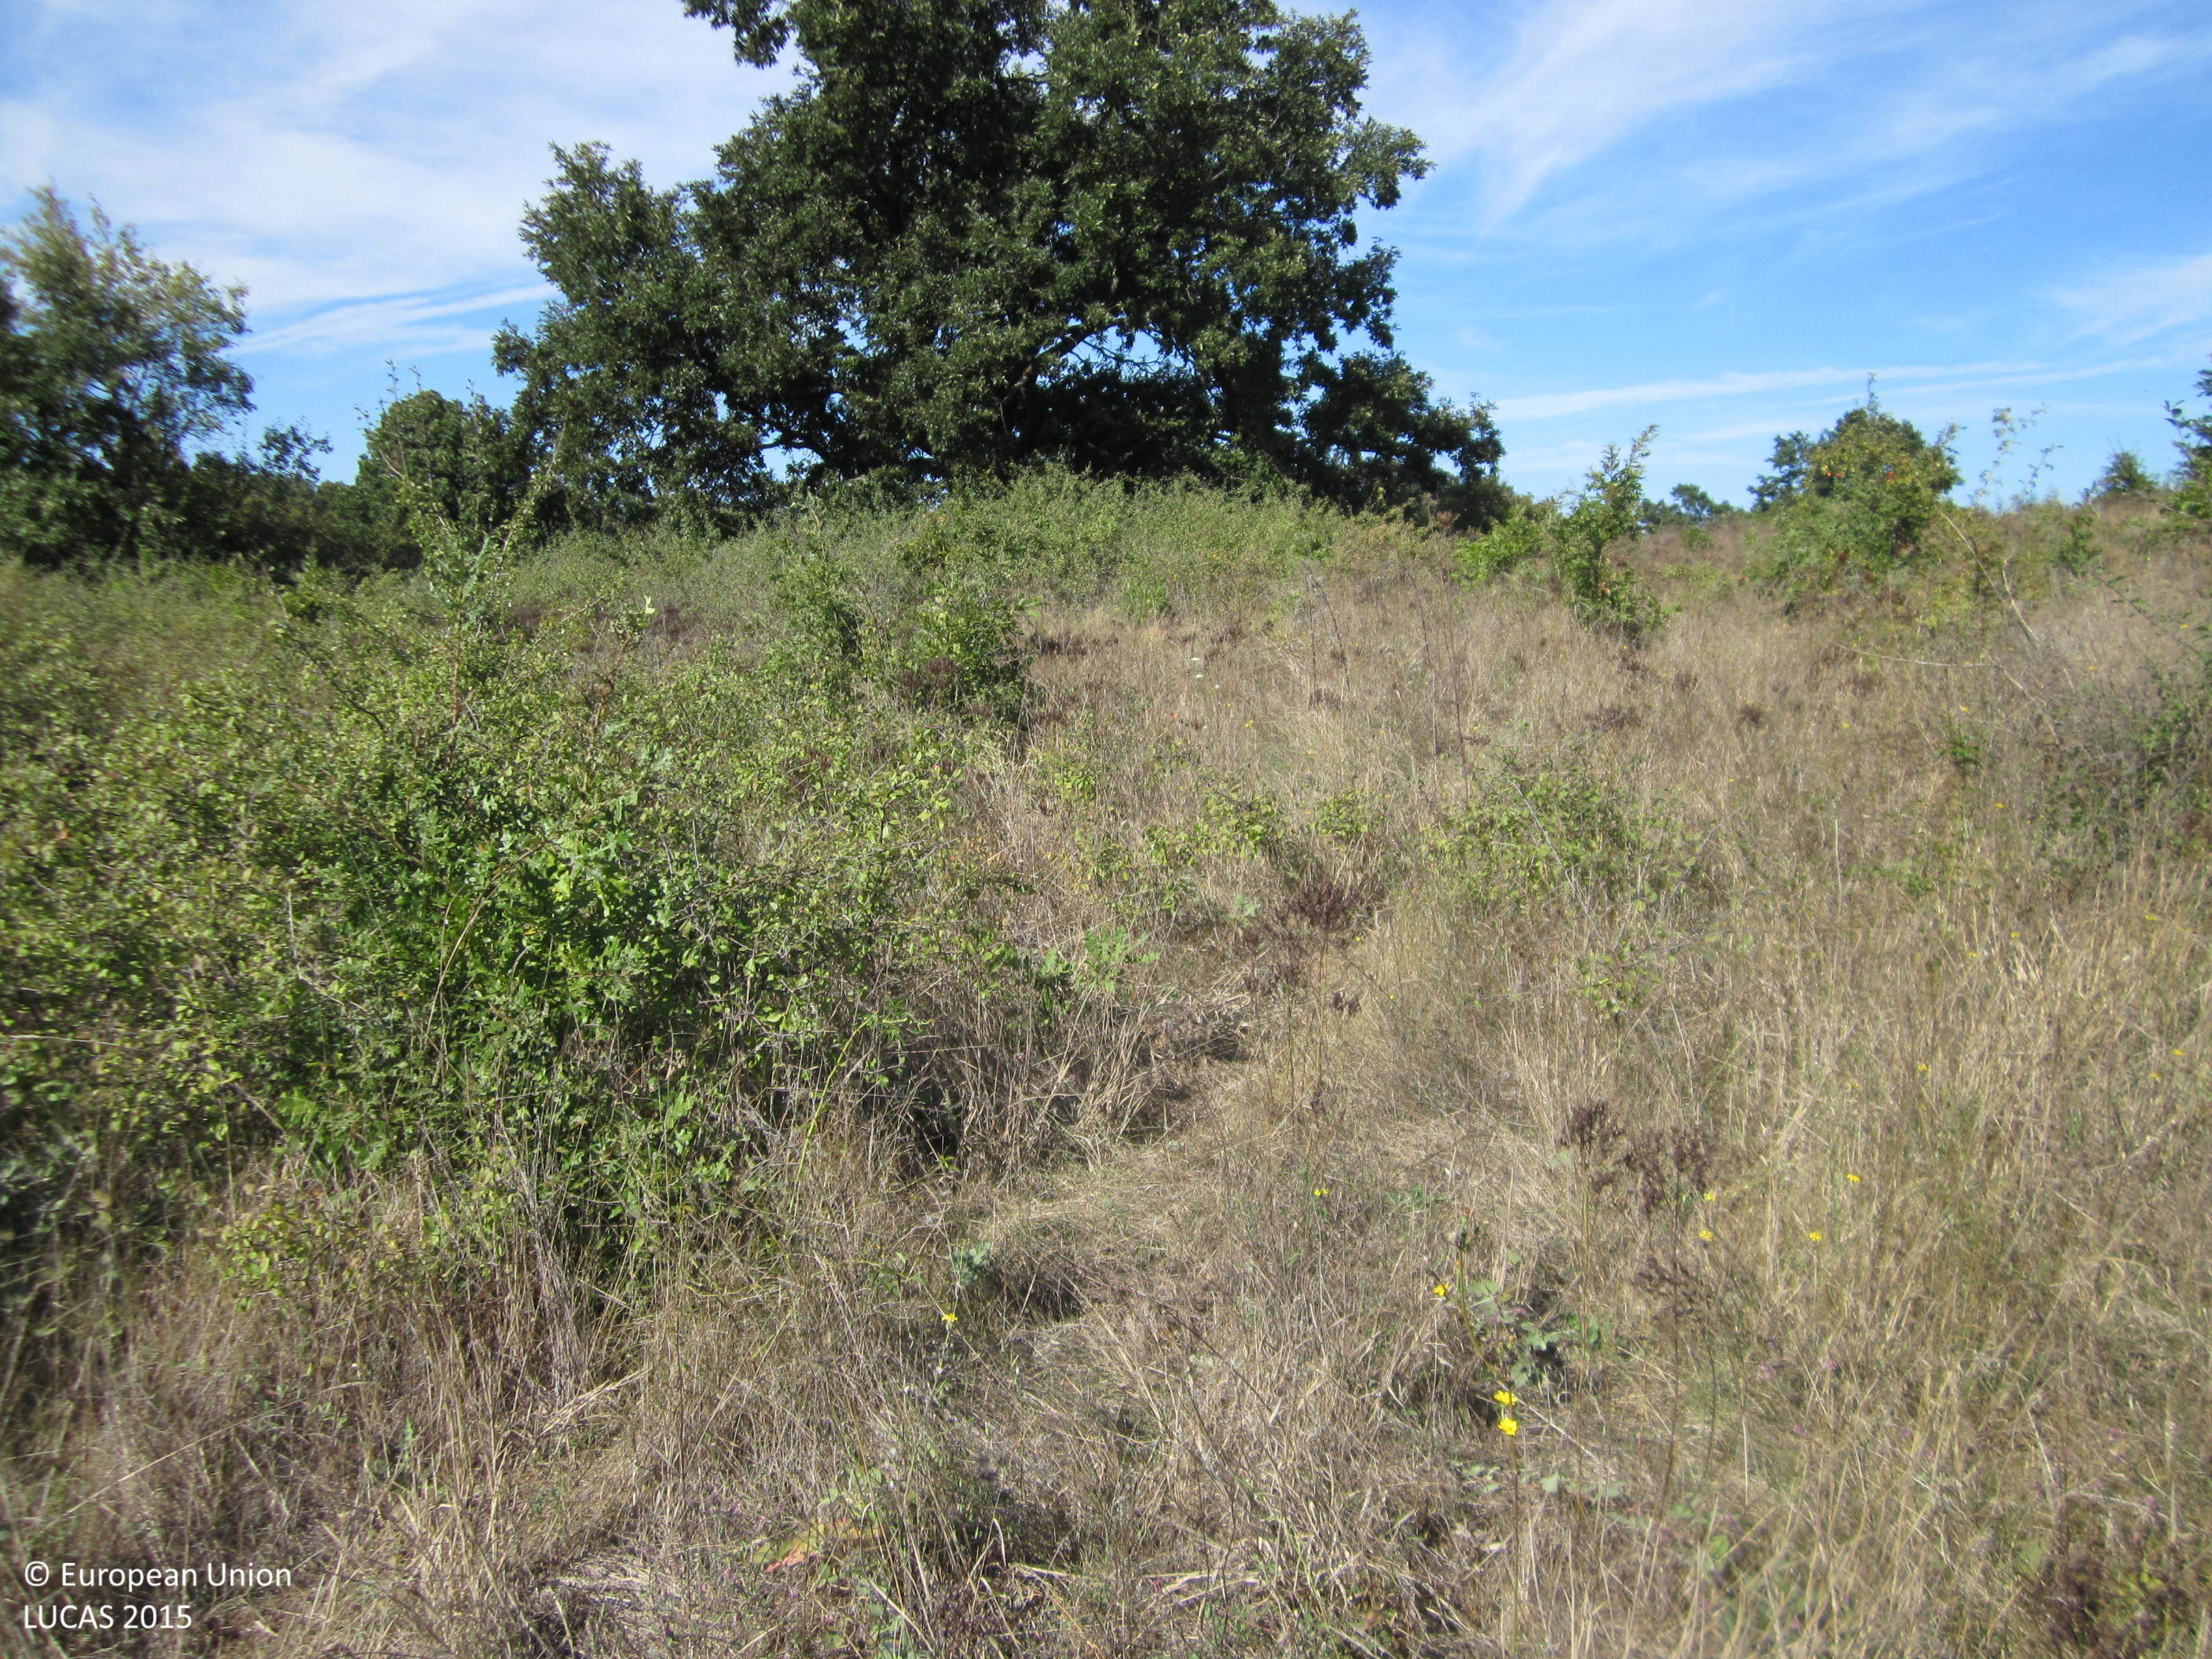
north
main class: Grassland
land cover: Grassland with sparse tree/shrub cover
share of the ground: > 75 %
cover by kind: herbaceous plants 85 %, shrubs 10 %, broadleaved forest trees 5 %
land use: Agriculture (excluding fallow land and kitchen gardens)
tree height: > 5 m
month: September
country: BG
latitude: 42.1039
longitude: 27.0171
